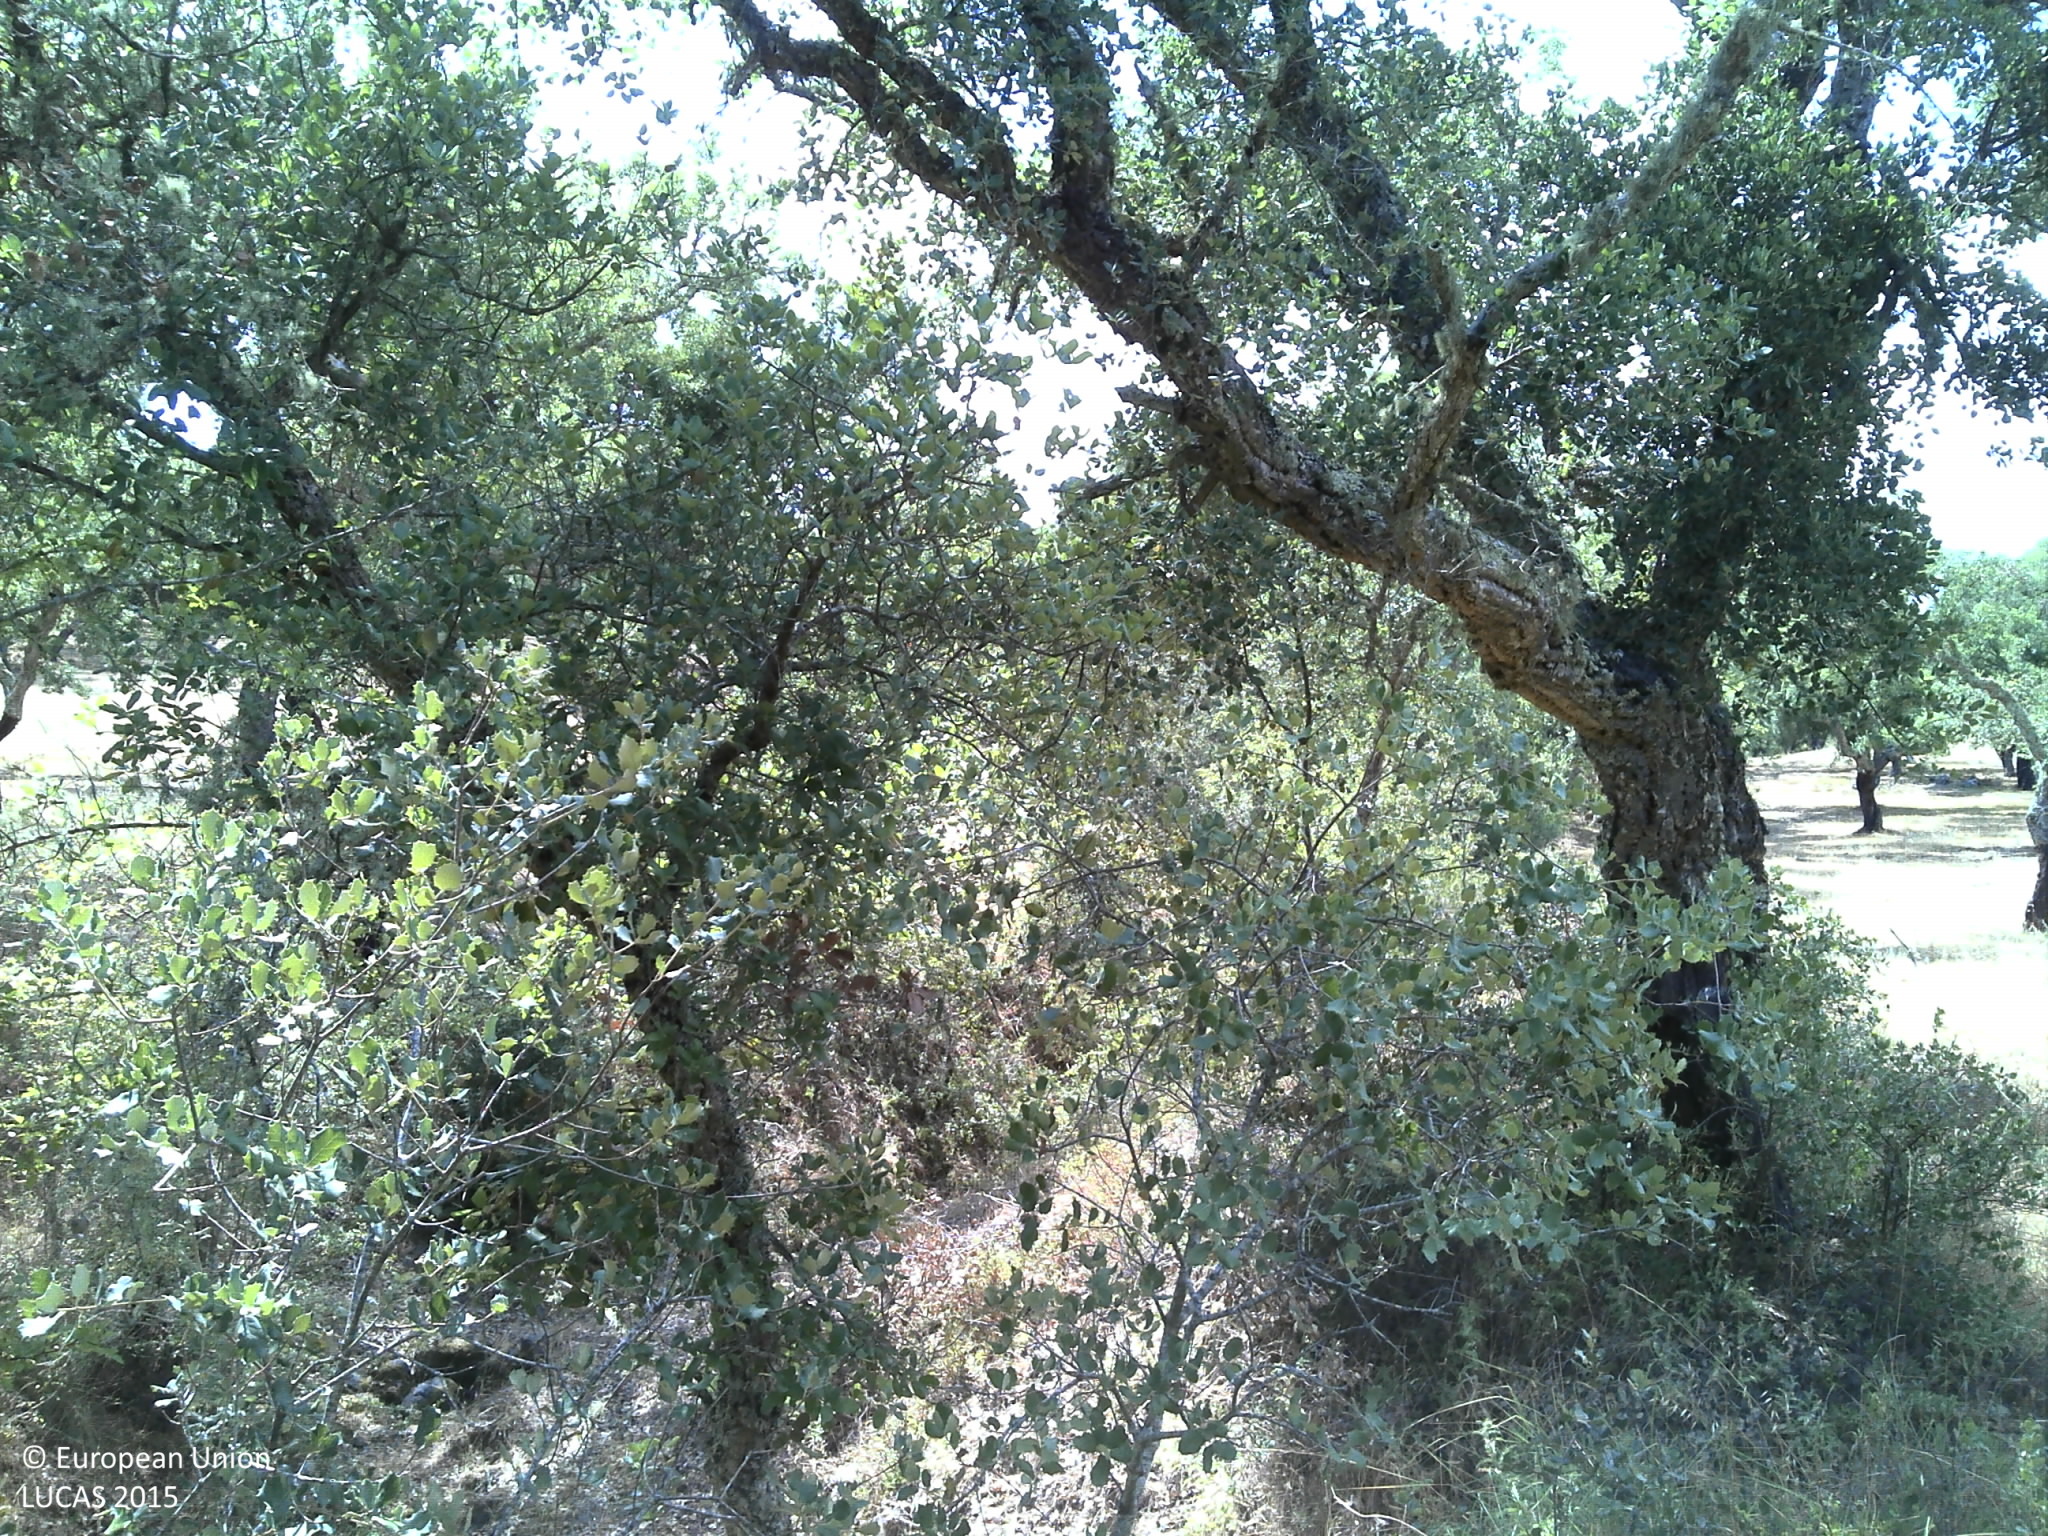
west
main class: Woodland
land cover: Broadleaved woodland
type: broadleaved evergreen forest
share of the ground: > 75 %
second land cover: Grassland without tree/shrub cover
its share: 10 - 25 %
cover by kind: broadleaved forest trees 80 %, herbaceous plants 10 %, unconsolidated bare surface 10 %
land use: Forestry
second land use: Agriculture (excluding fallow land and kitchen gardens)
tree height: > 5 m
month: June
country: PT
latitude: 38.5726
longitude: -8.0754
